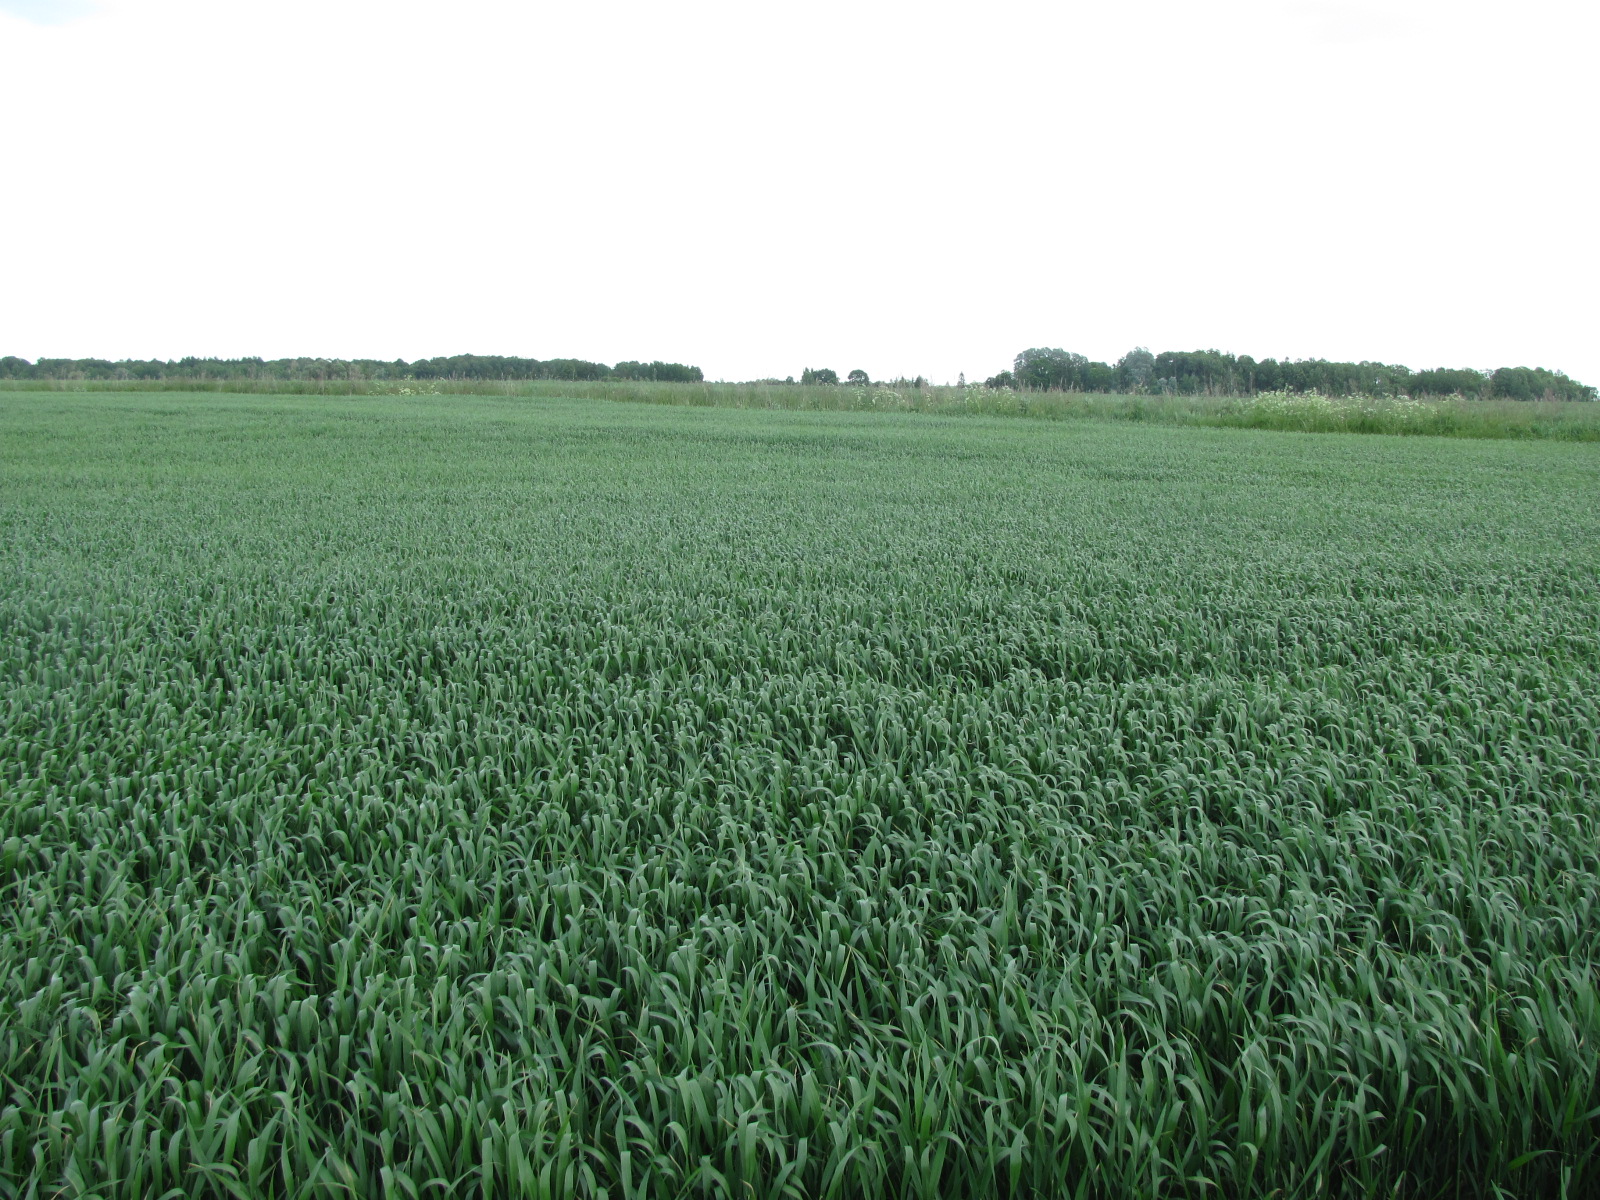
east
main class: Cropland
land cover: Common wheat
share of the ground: > 75 %
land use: Agriculture (excluding fallow land and kitchen gardens)
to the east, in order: Common wheat; Spontaneously vegetated surfaces; Ditches and canals
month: June
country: LV
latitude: 56.2542
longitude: 24.1811
